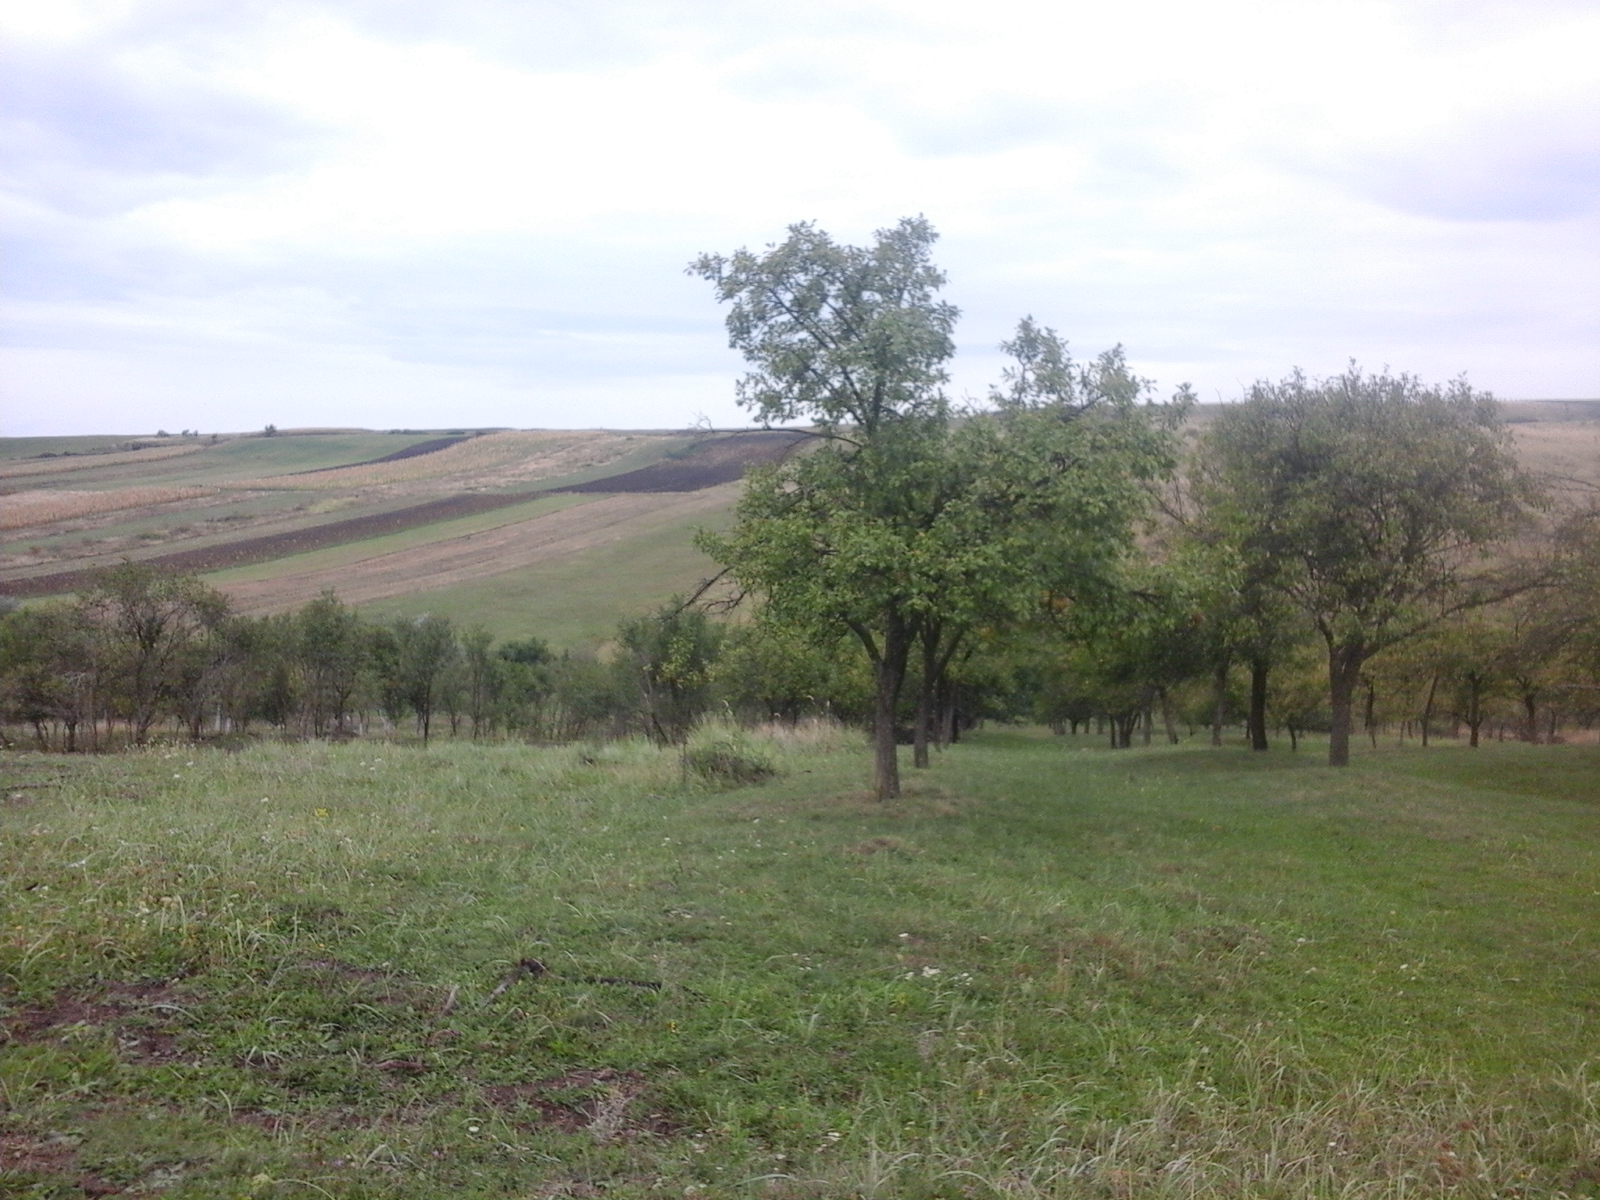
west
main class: Grassland
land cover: Grassland without tree/shrub cover
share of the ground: > 75 %
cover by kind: herbaceous plants 100 %
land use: Agriculture (excluding fallow land and kitchen gardens)
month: September
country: RO
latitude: 47.3137
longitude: 22.6117
